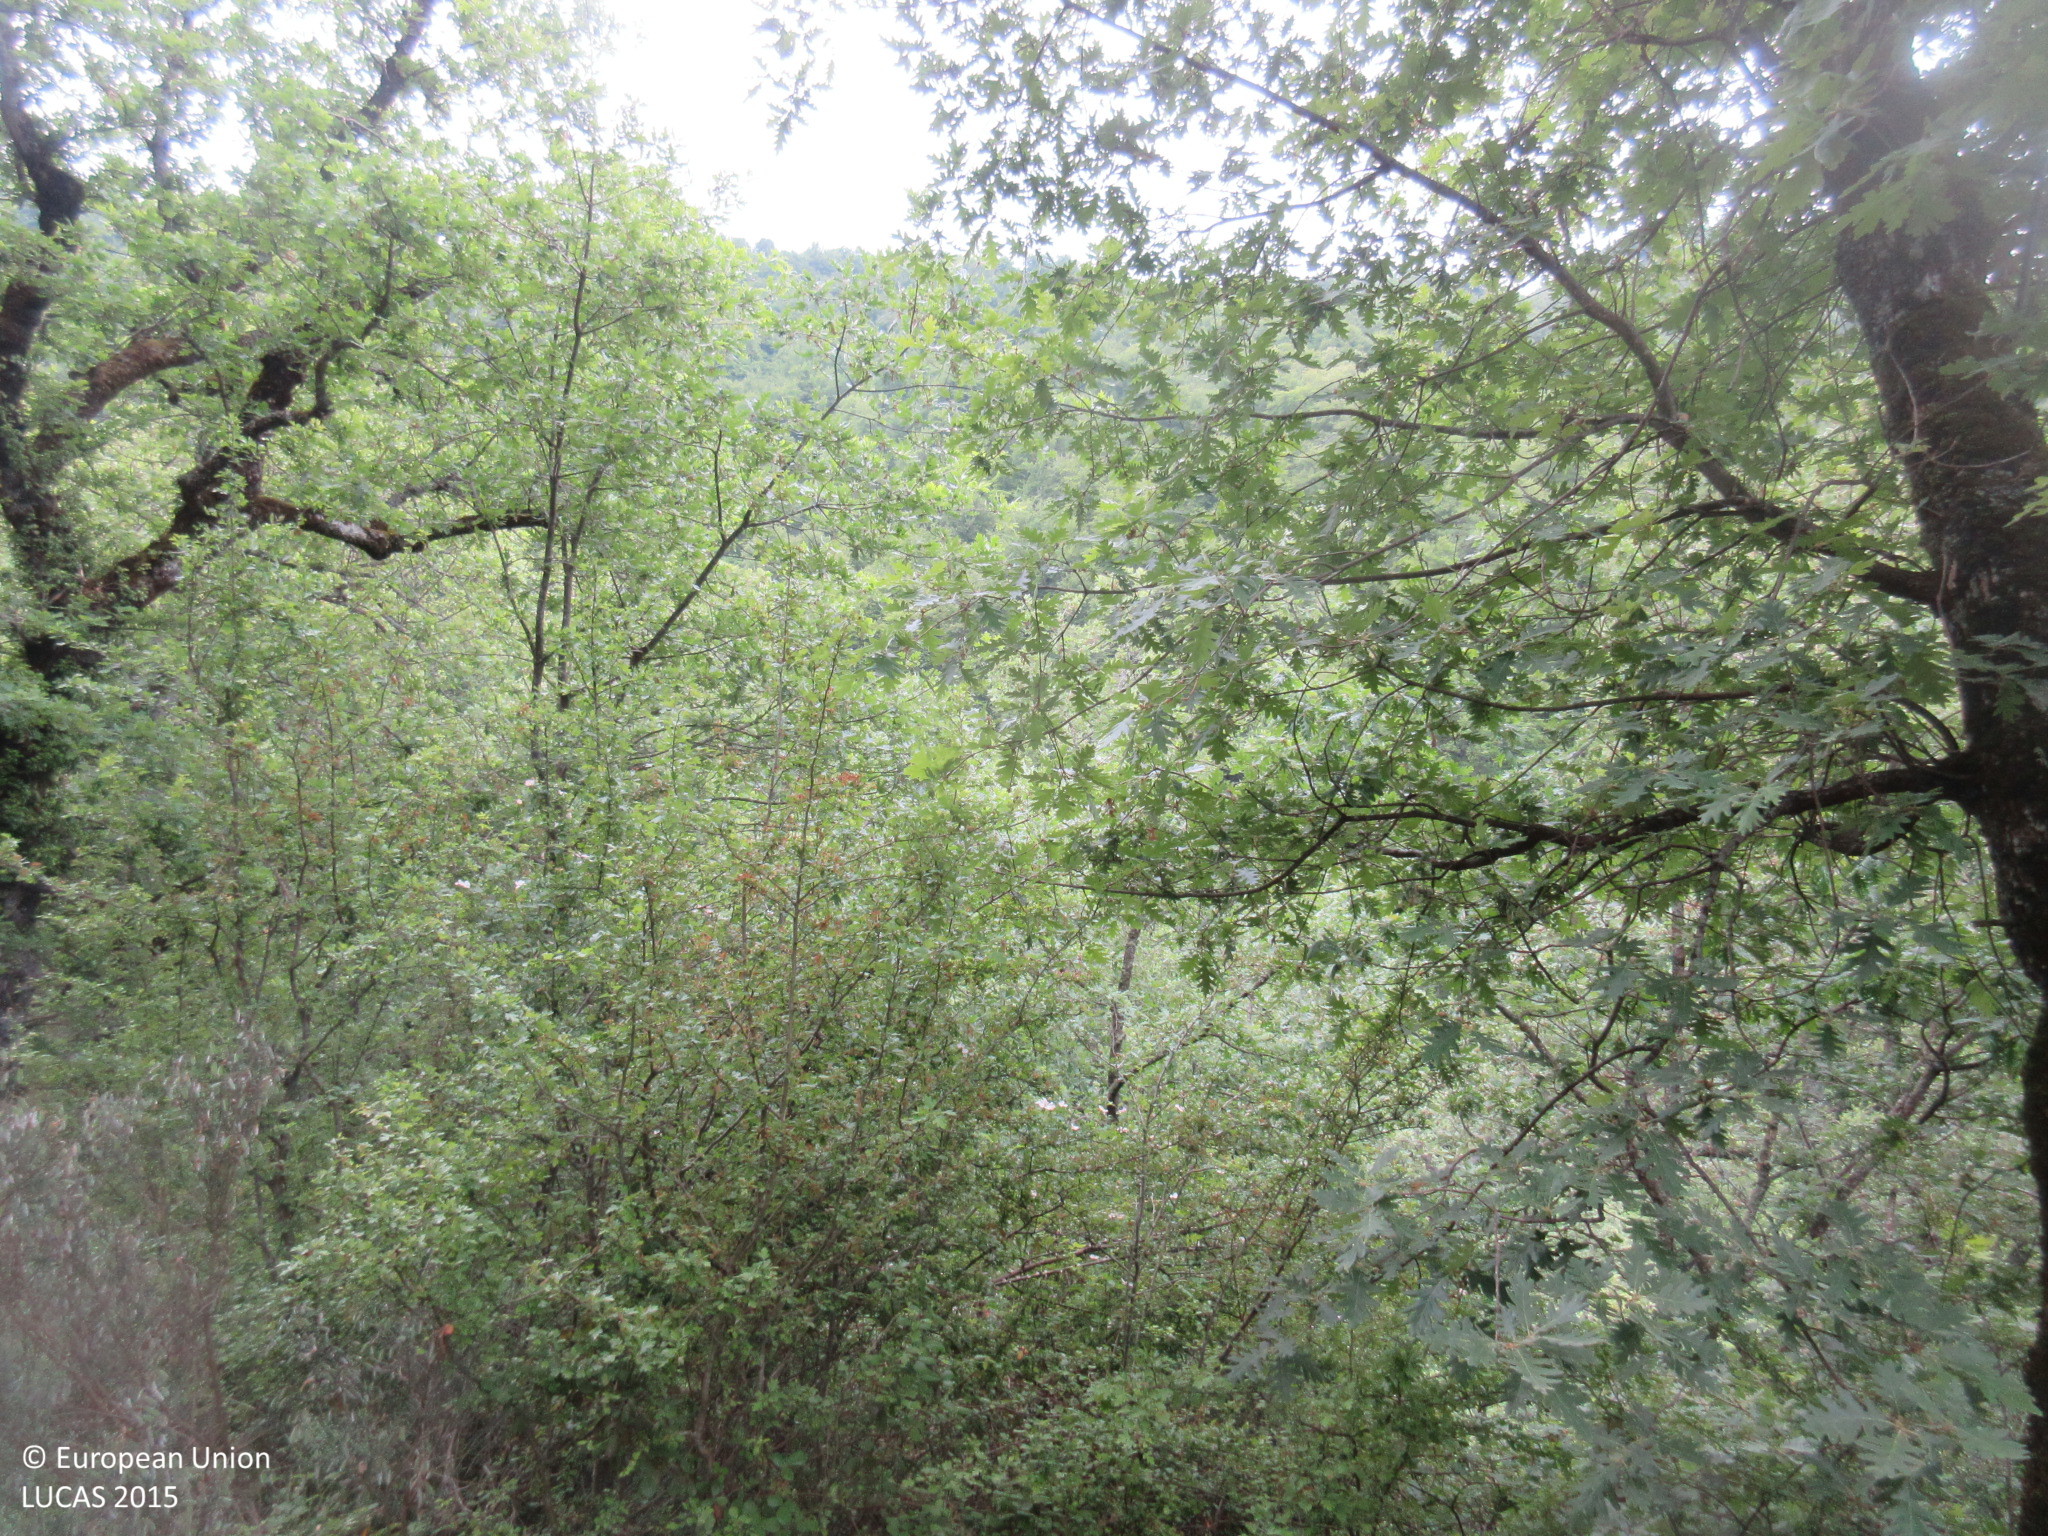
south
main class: Woodland
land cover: Broadleaved woodland
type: thermophilous deciduous forest
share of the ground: > 75 %
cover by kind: broadleaved forest trees 95 %, unconsolidated bare surface 5 %
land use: Semi-natural and natural areas not in use
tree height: > 5 m
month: June
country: ES
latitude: 43.1385
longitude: -4.5289
